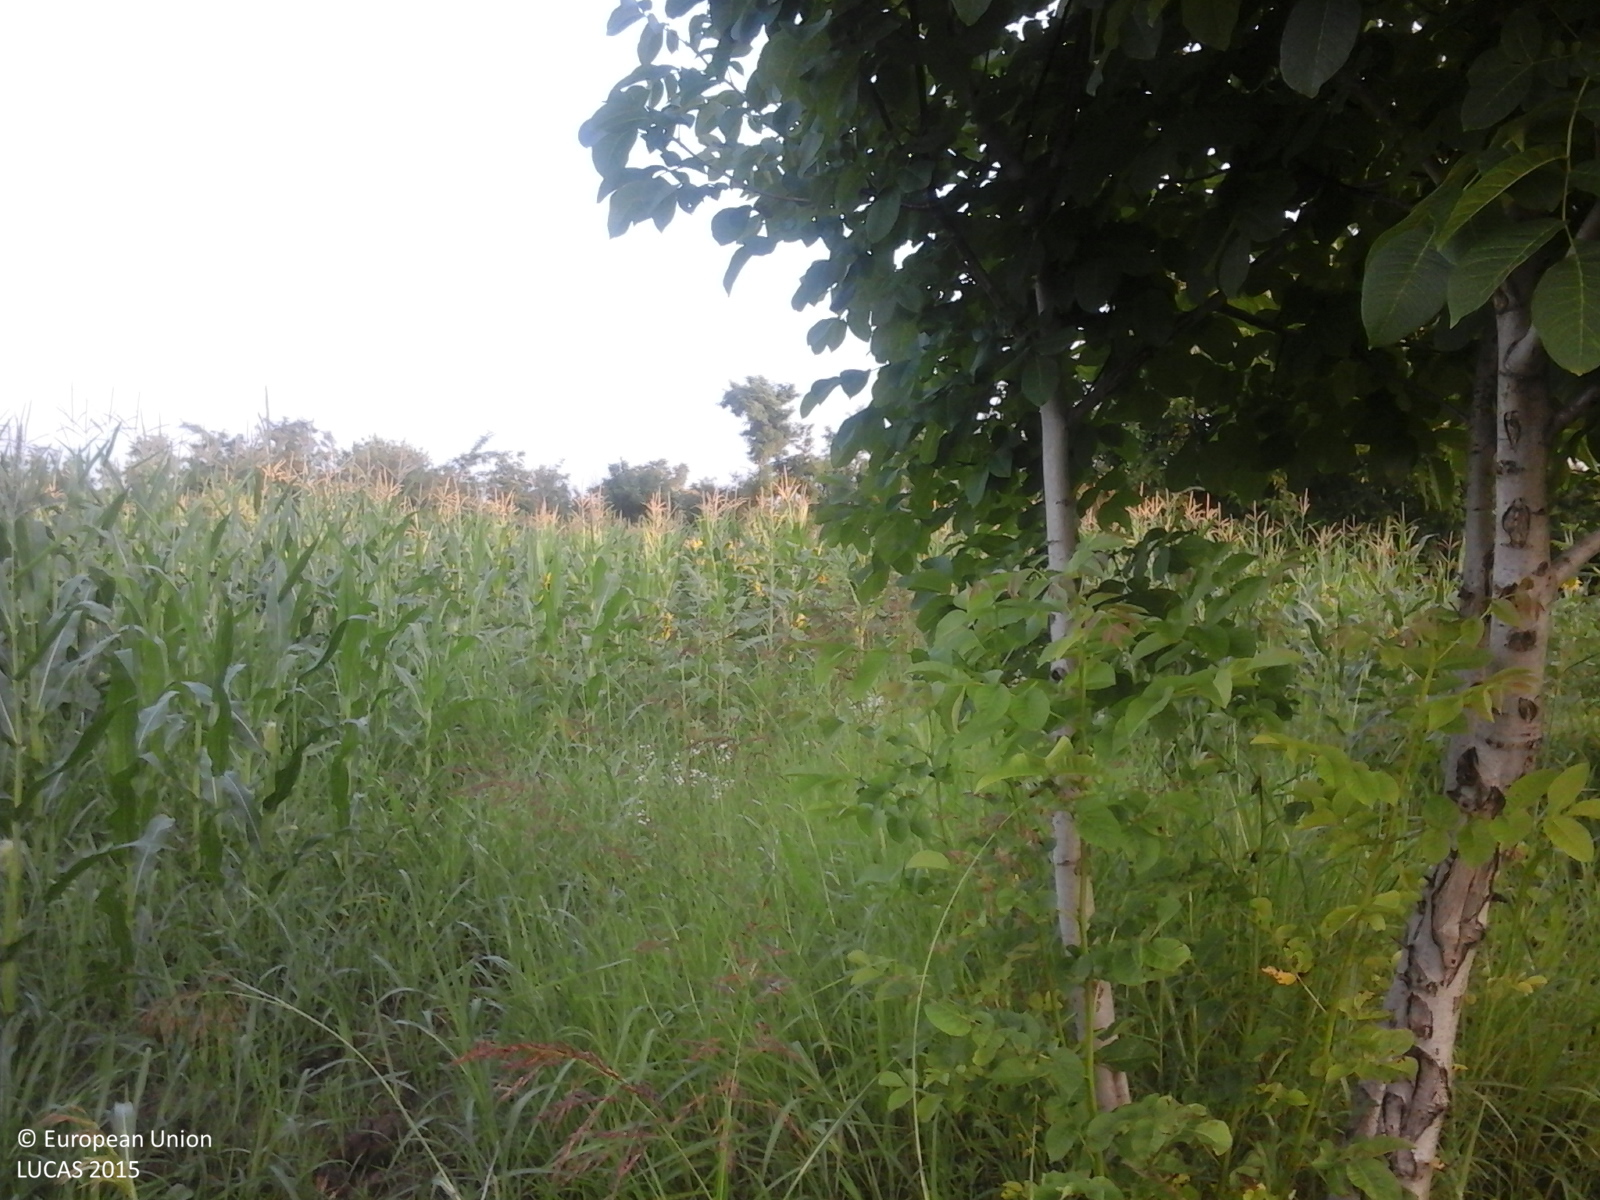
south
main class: Cropland
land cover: Maize
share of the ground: > 75 %
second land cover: Sunflower
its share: > 75 %
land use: Agriculture (excluding fallow land and kitchen gardens)
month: July
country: RO
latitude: 43.8635
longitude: 25.4507
